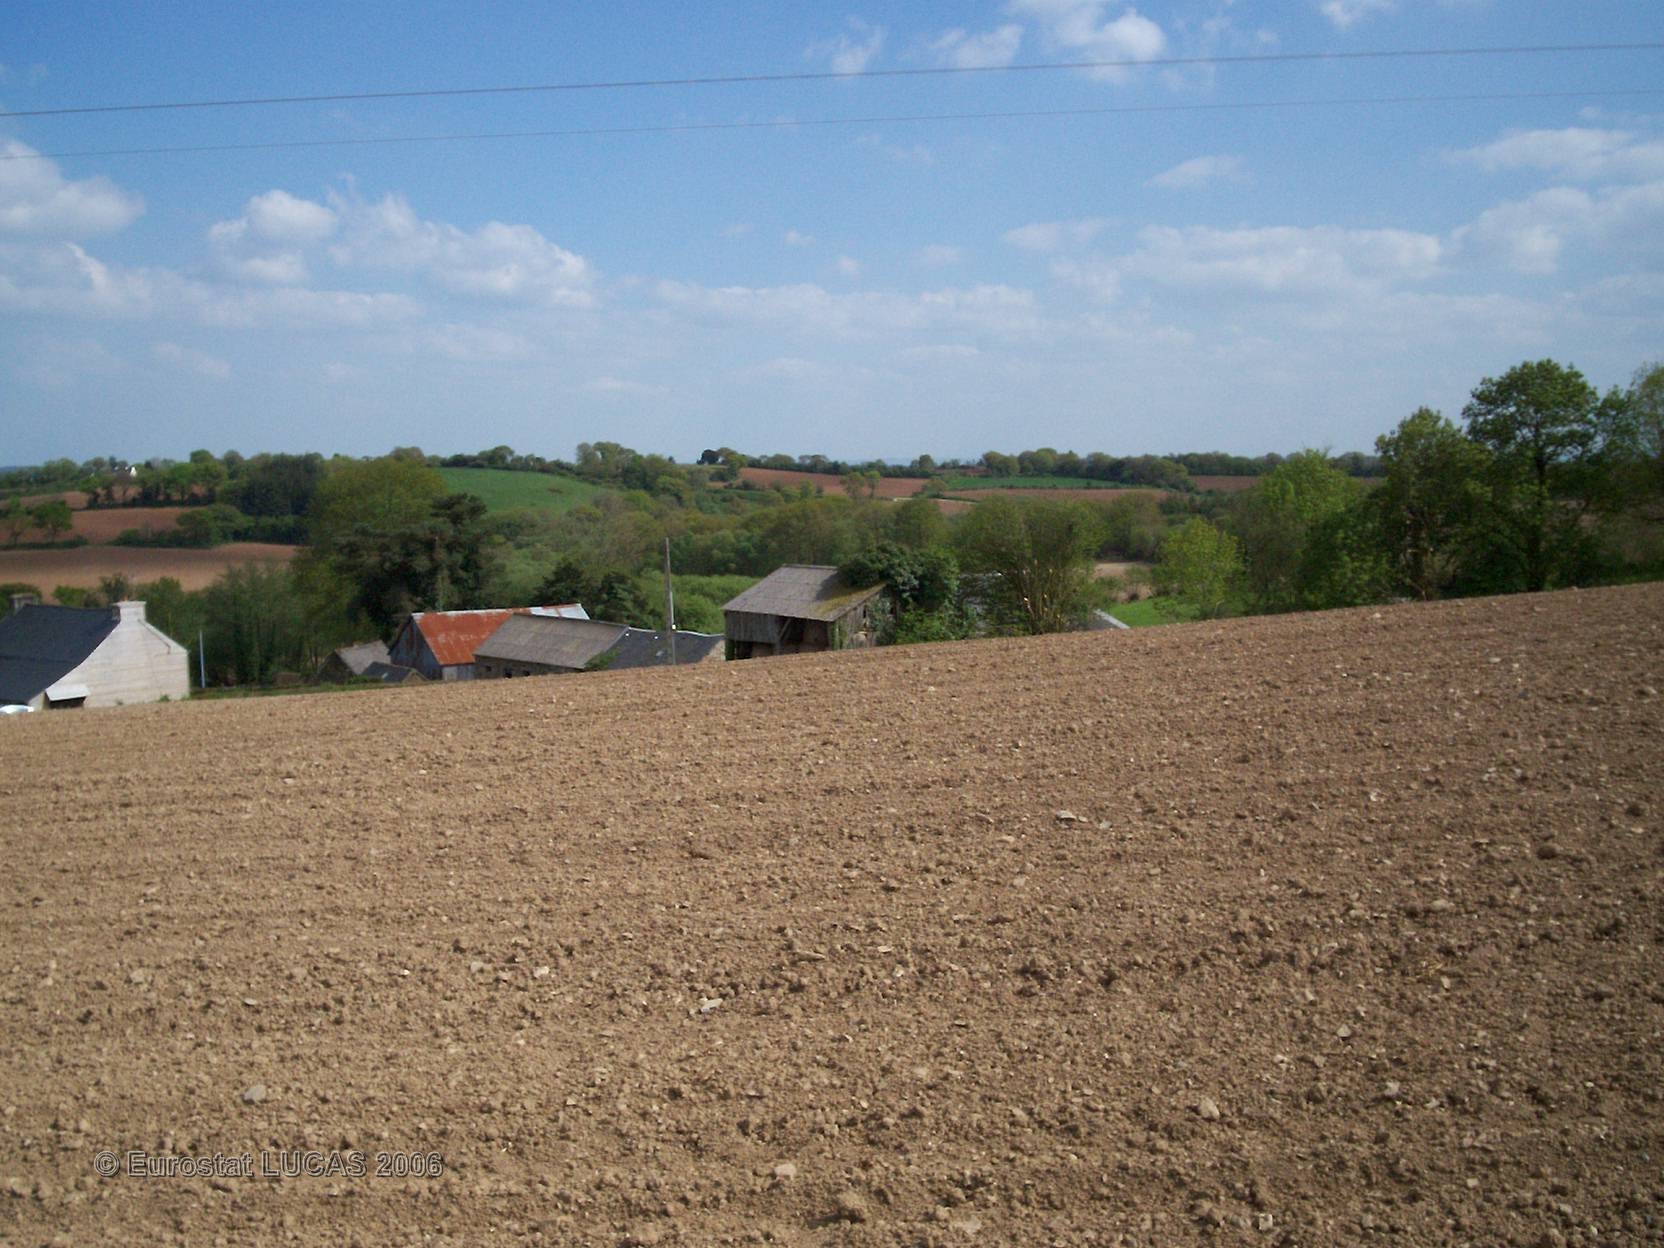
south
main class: Cropland
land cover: Maize
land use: Agriculture (excluding fallow land and kitchen gardens)
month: May
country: FR
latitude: 48.4085
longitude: -3.6585
